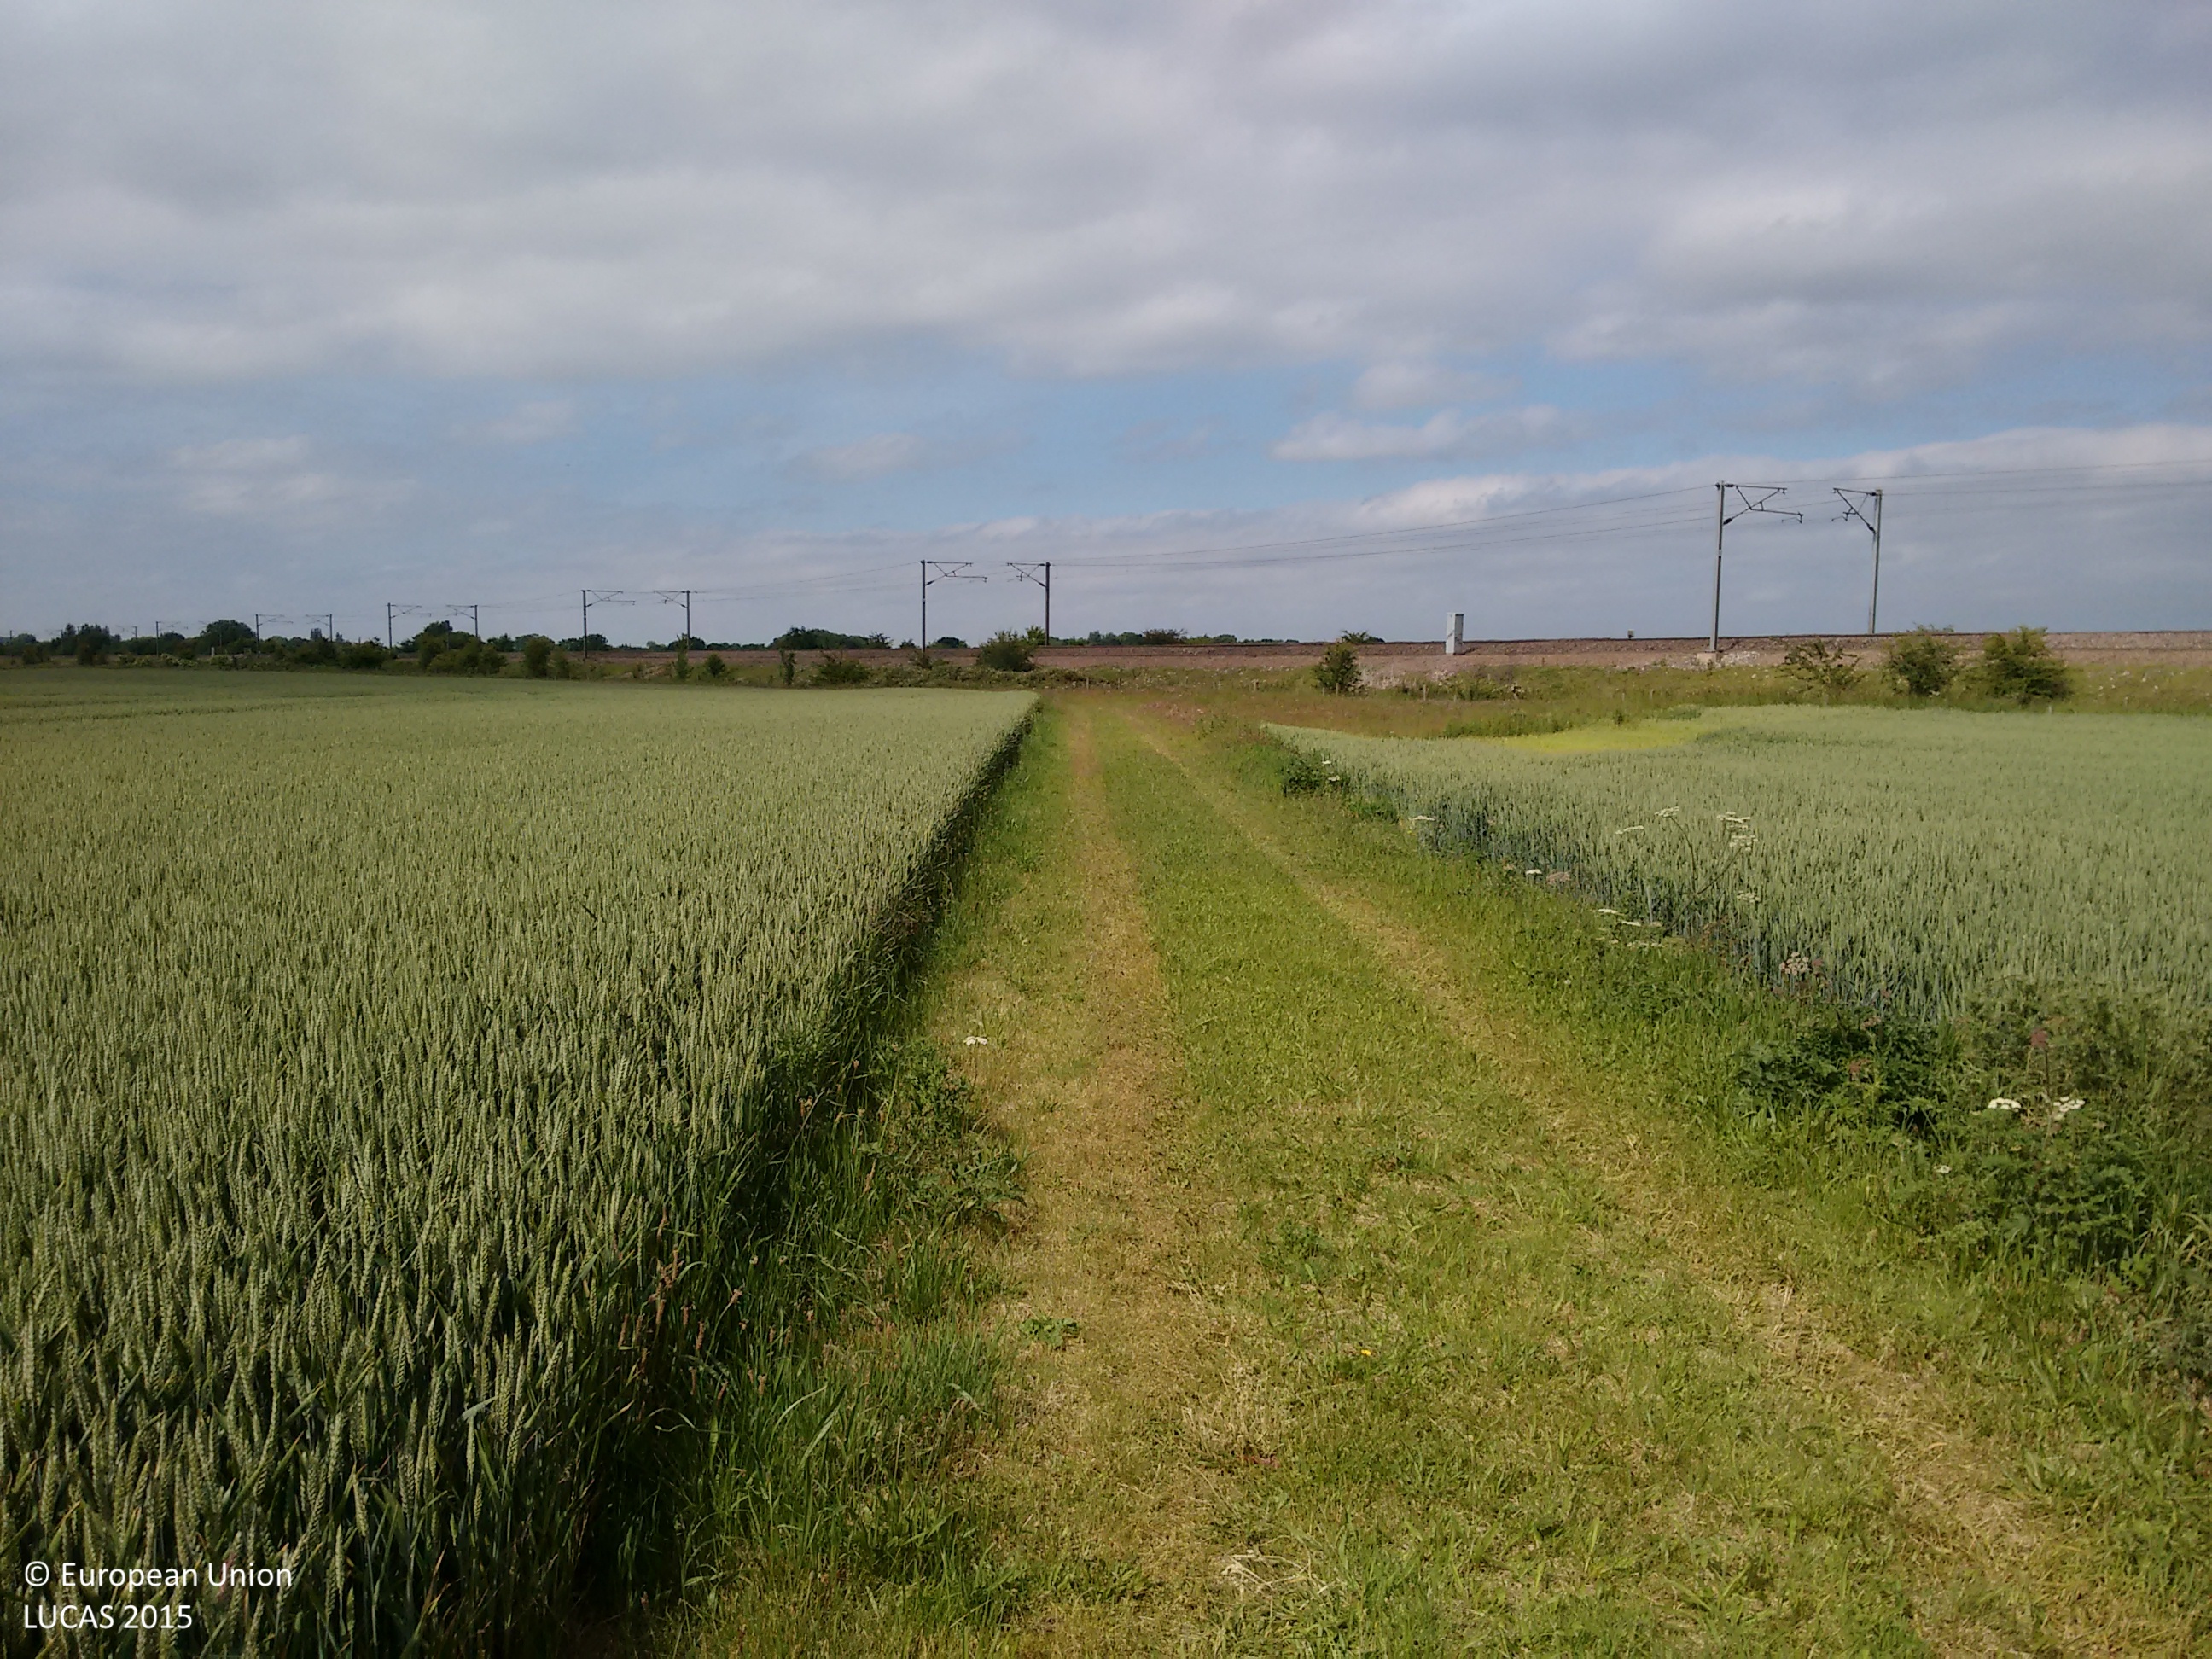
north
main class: Cropland
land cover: Common wheat
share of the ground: > 75 %
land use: Agriculture (excluding fallow land and kitchen gardens)
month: June
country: GB
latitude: 53.7257
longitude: -1.0931
